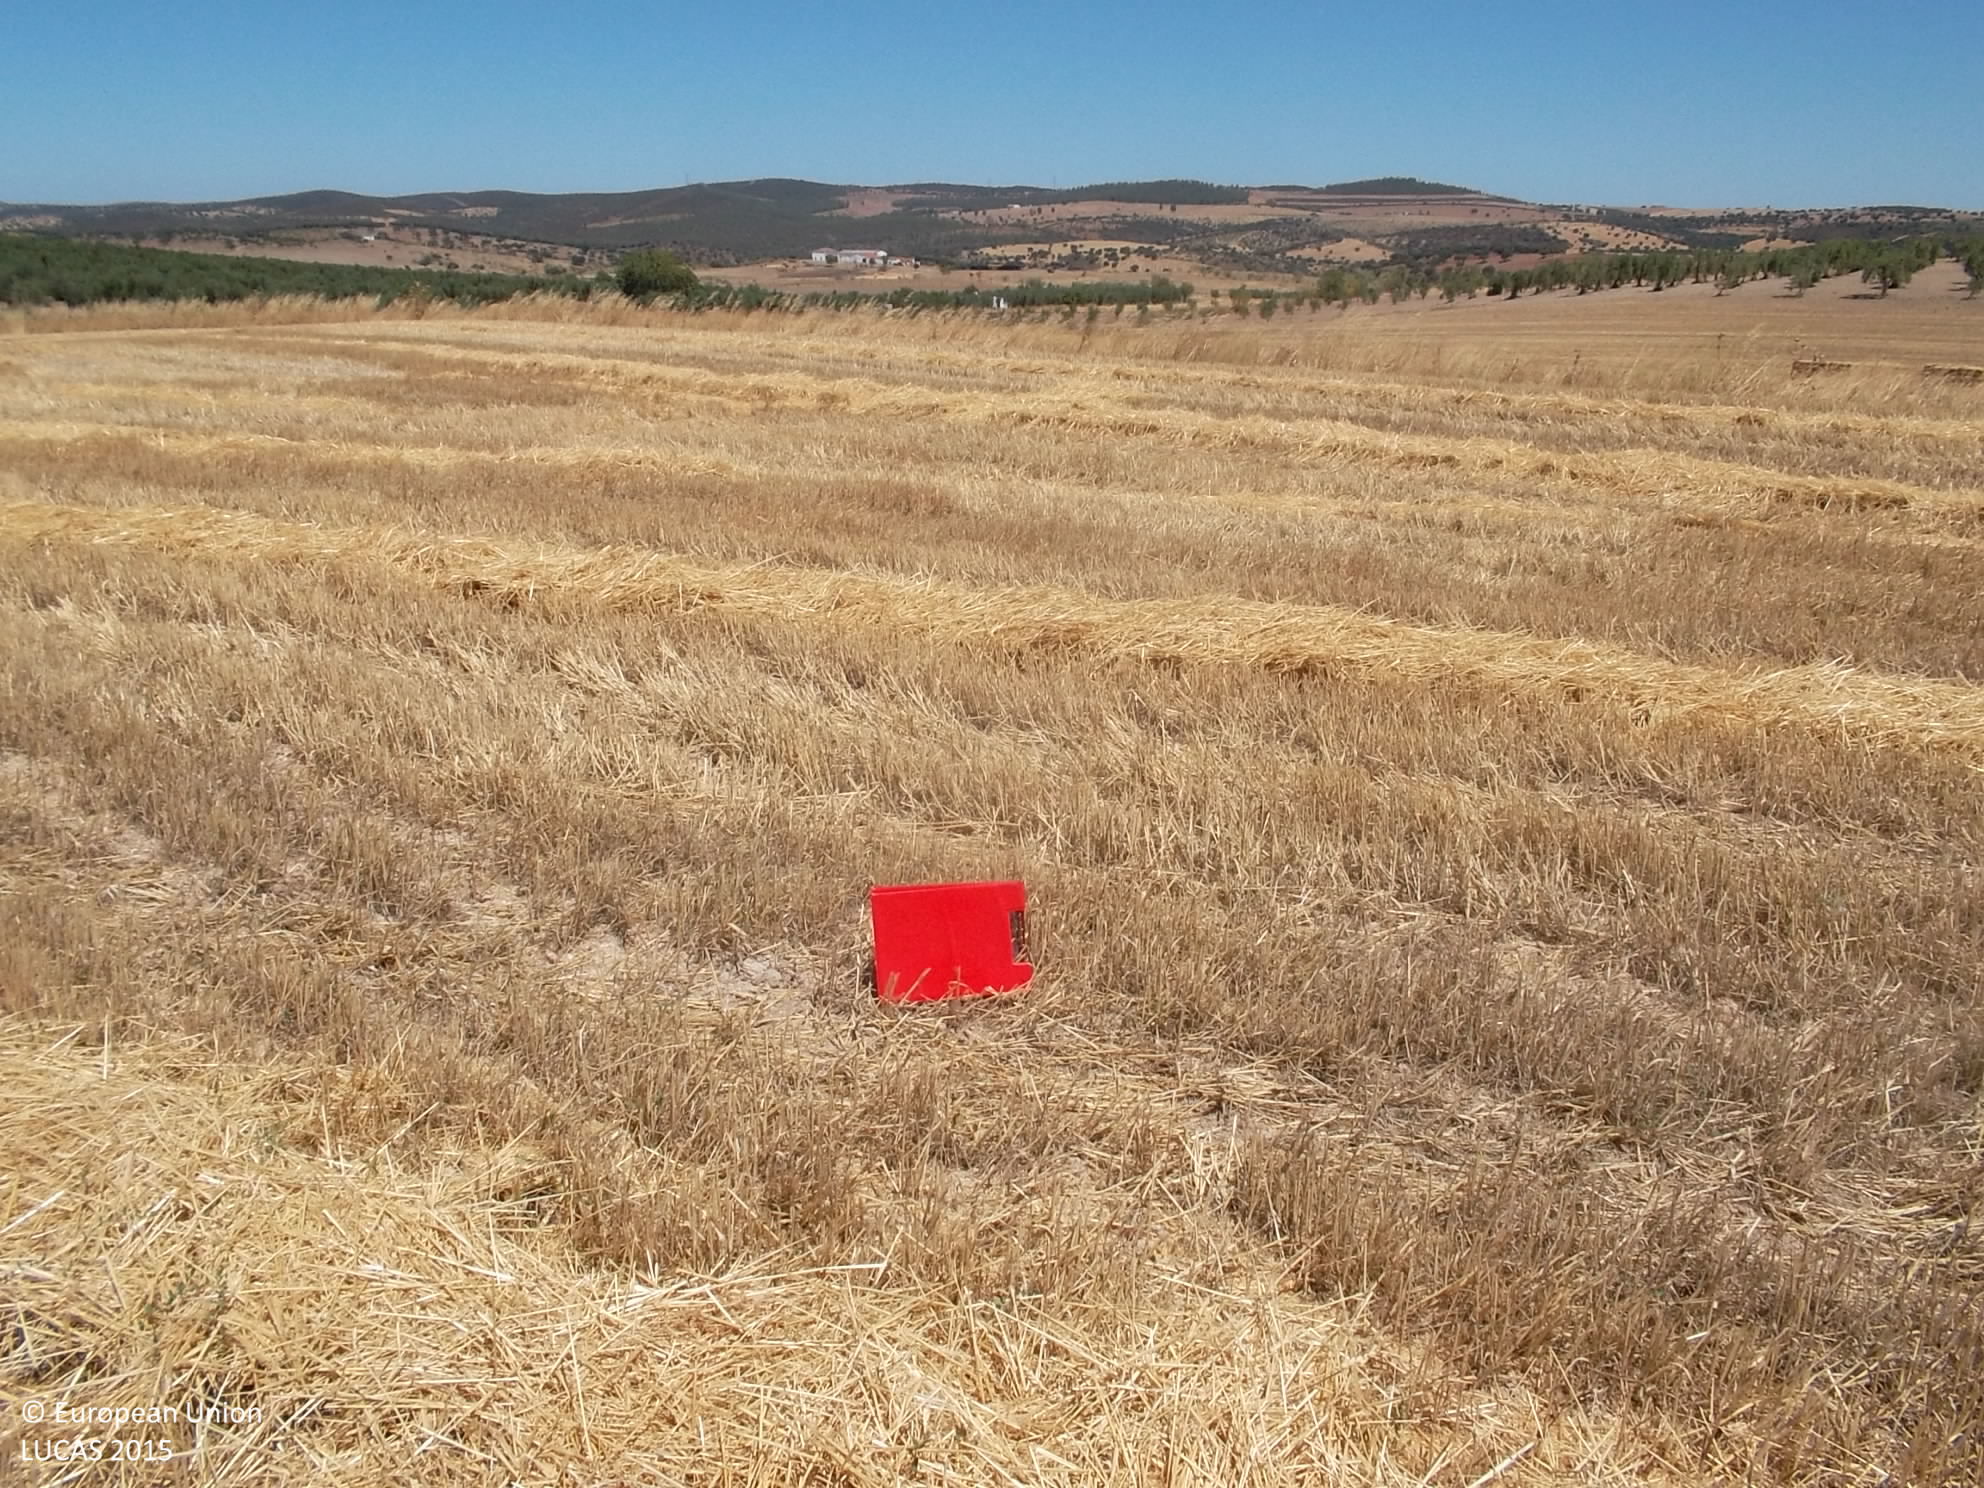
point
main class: Cropland
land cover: Common wheat
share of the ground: < 10 %
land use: Agriculture (excluding fallow land and kitchen gardens)
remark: Harvested field
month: July
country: ES
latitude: 38.3847
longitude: -5.8259
